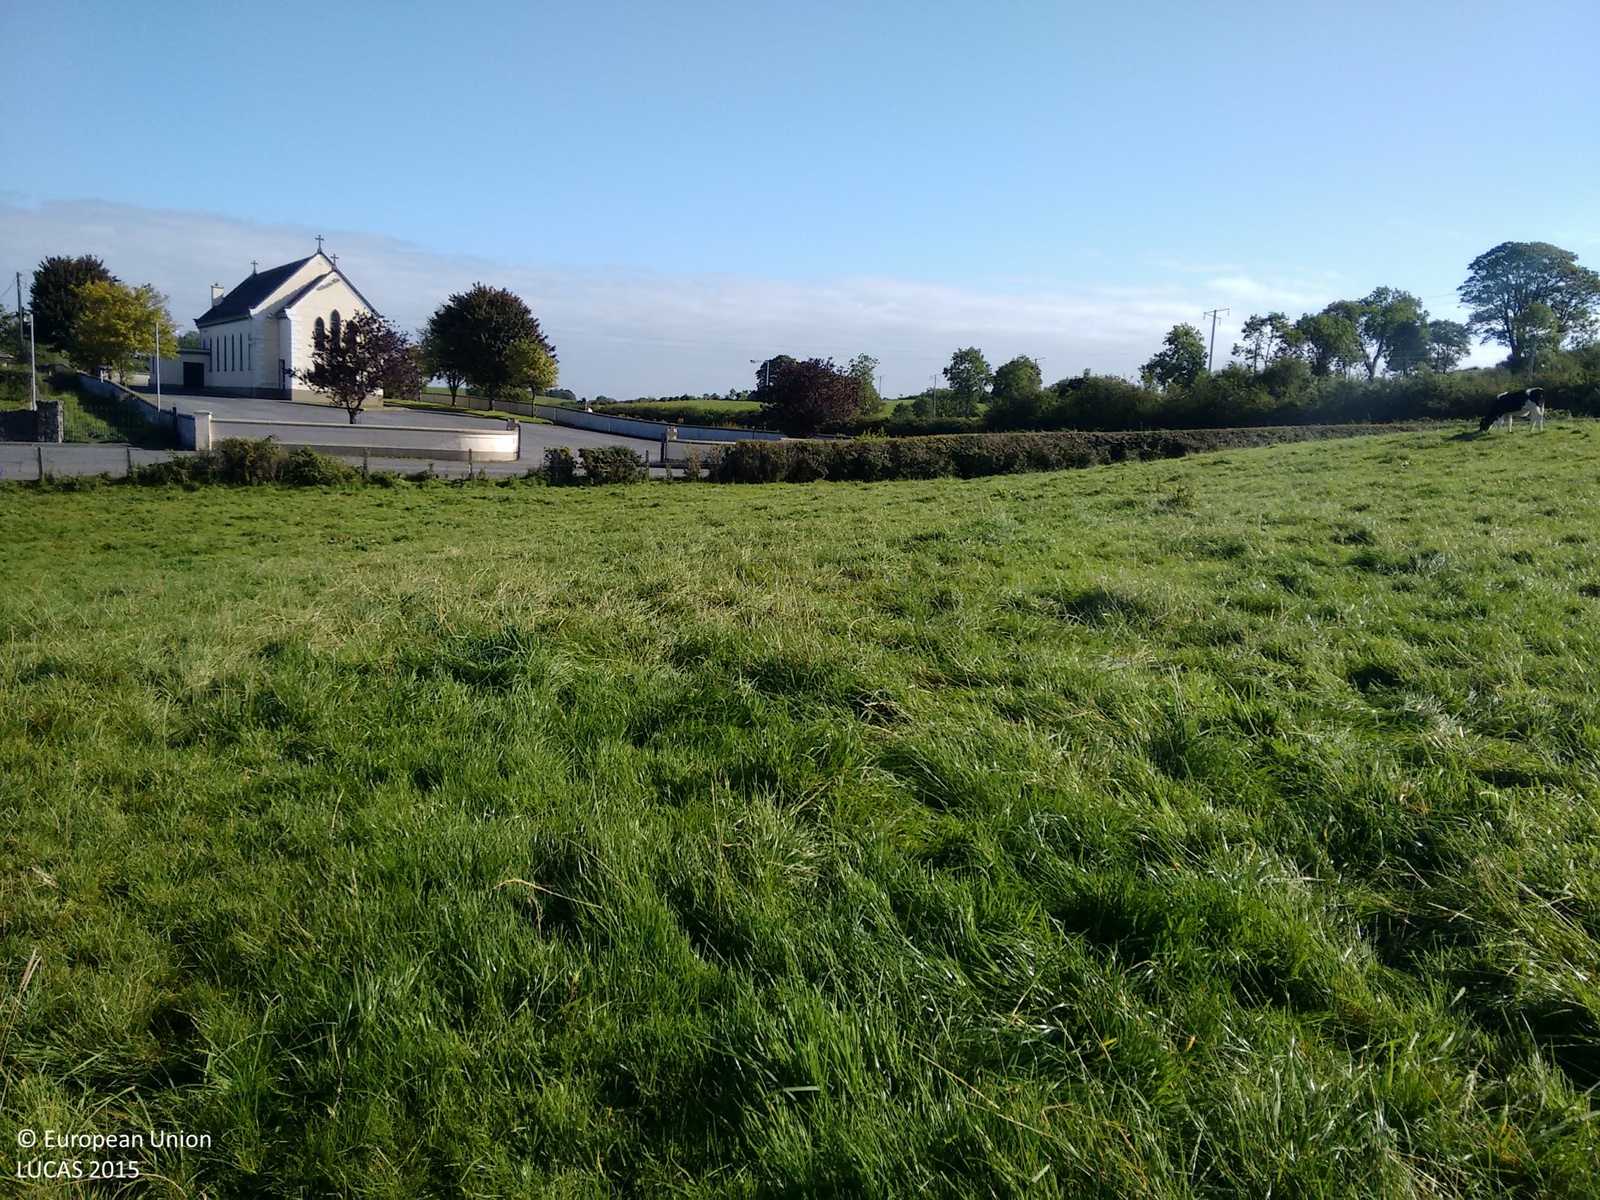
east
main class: Grassland
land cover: Grassland without tree/shrub cover
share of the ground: > 75 %
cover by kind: herbaceous plants 95 %, consolidated bare surface 5 %
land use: Agriculture (excluding fallow land and kitchen gardens)
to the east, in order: Managed hedges; Grassland without tree/shrub cover; Fences; Managed hedges; Grass margins; Artificial constructions in urban areas; Grassland without tree/shrub cover; Electric lines; Grassland without tree/shrub cover; Managed hedges; Fences; Grassland without tree/shrub cover; Electric lines; Grassland without tree/shrub cover; Fences; Tracks; Fences; Grassland without tree/shrub cover; Electric lines; Grassland without tree/shrub cover
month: September
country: IE
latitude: 54.1207
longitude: -6.8591
